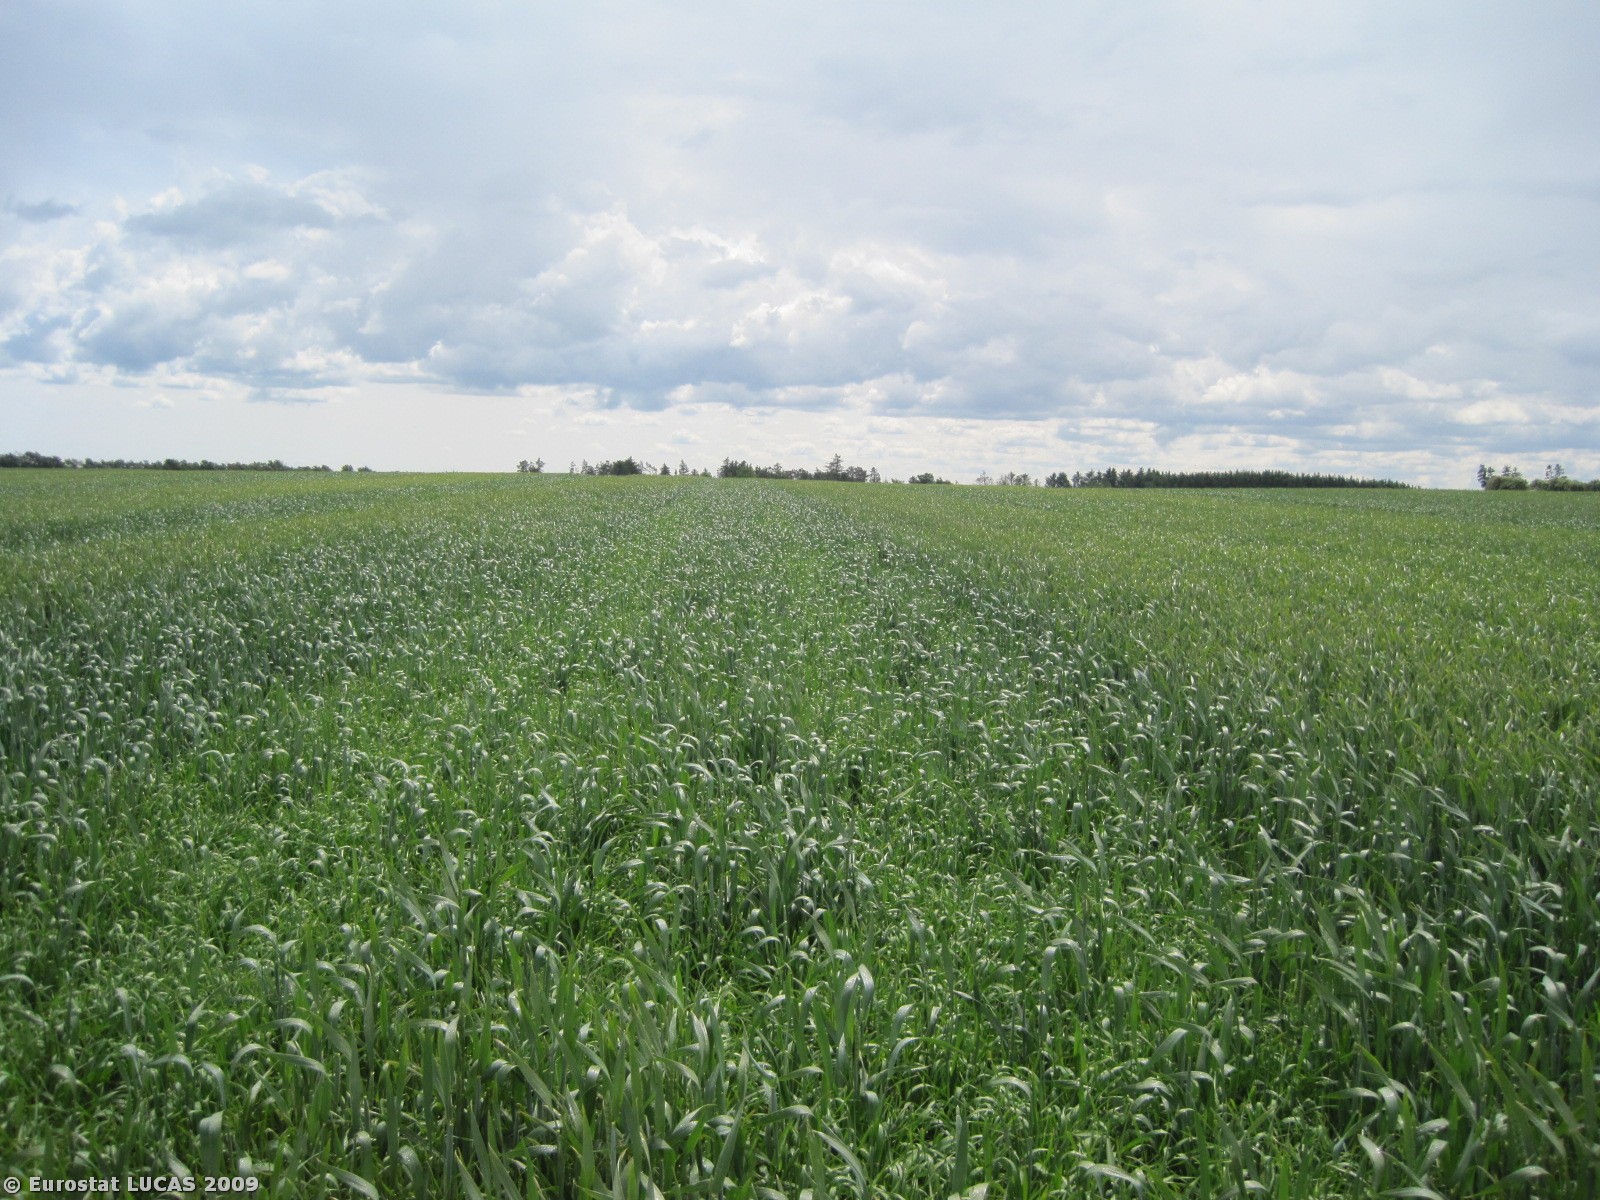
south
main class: Cropland
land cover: Common wheat
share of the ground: 50 - 75 %
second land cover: Barley
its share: 10 - 25 %
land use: Agriculture (excluding fallow land and kitchen gardens)
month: June
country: DK
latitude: 57.3023
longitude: 9.8509
